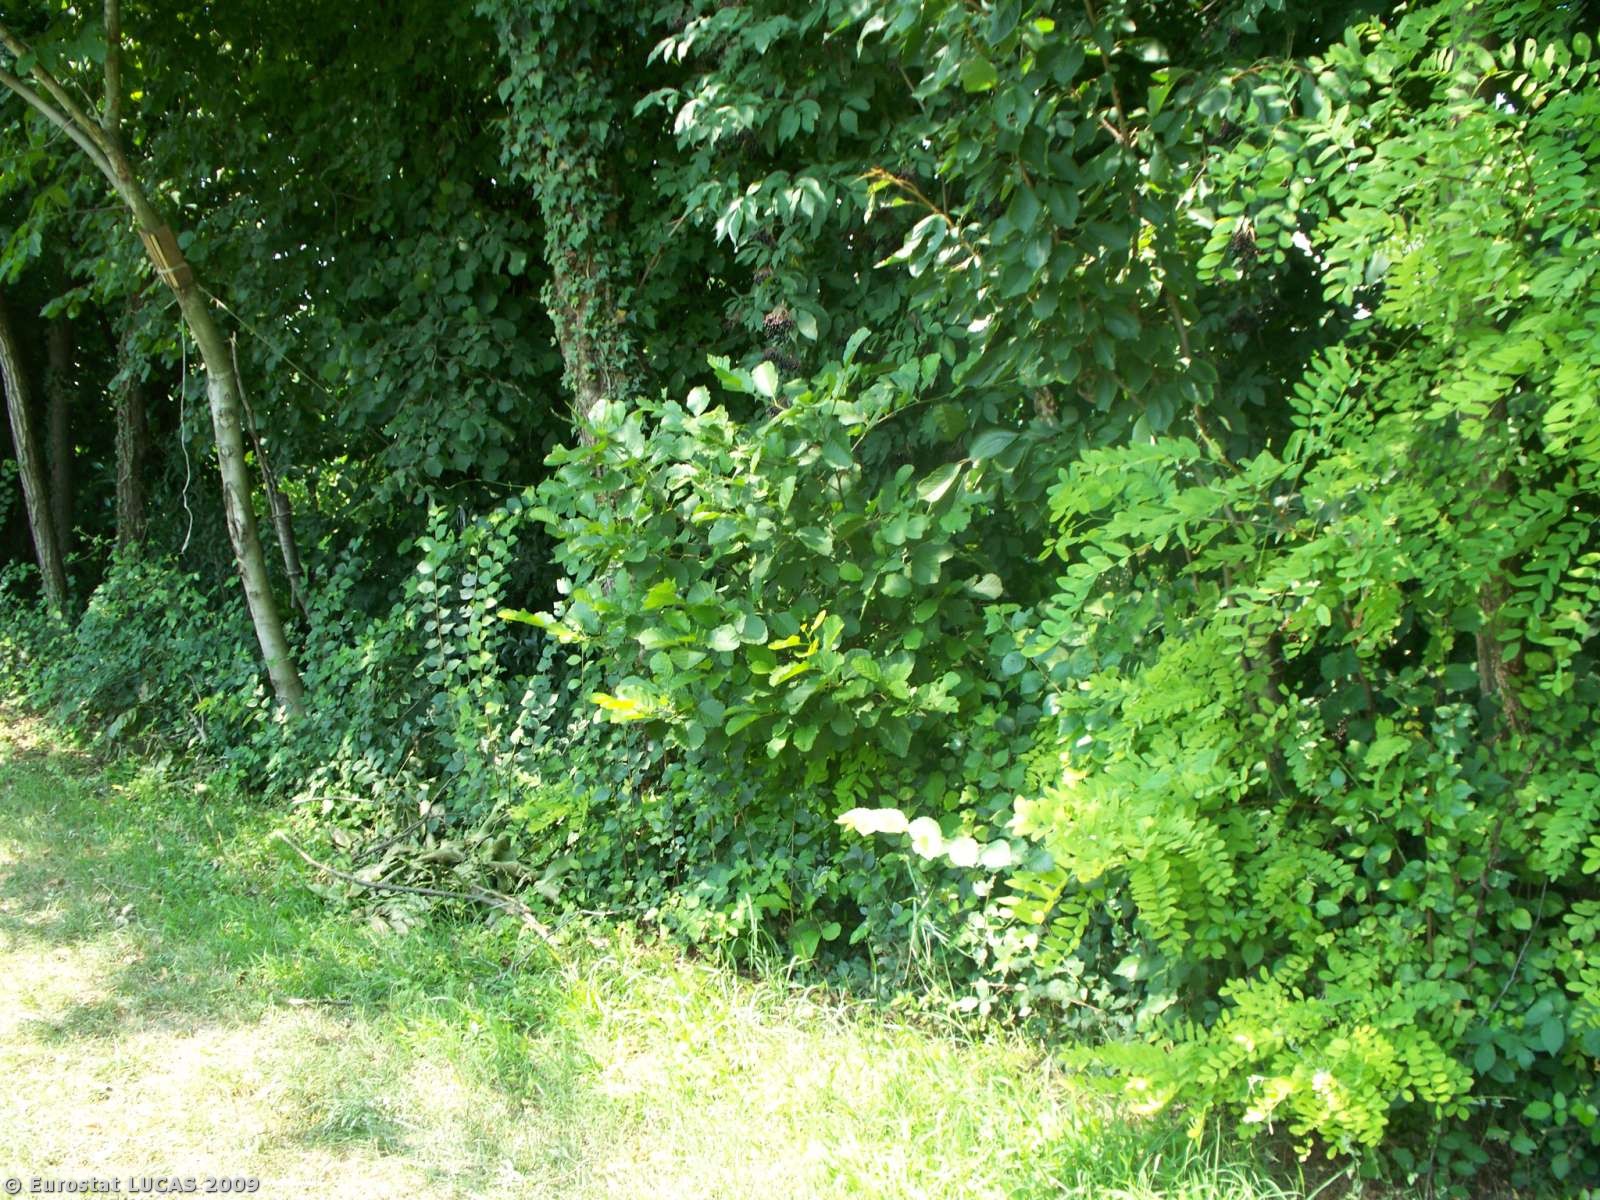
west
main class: Cropland
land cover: Maize
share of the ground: > 75 %
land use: Agriculture (excluding fallow land and kitchen gardens)
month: July
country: IT
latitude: 45.8910
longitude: 12.4324
